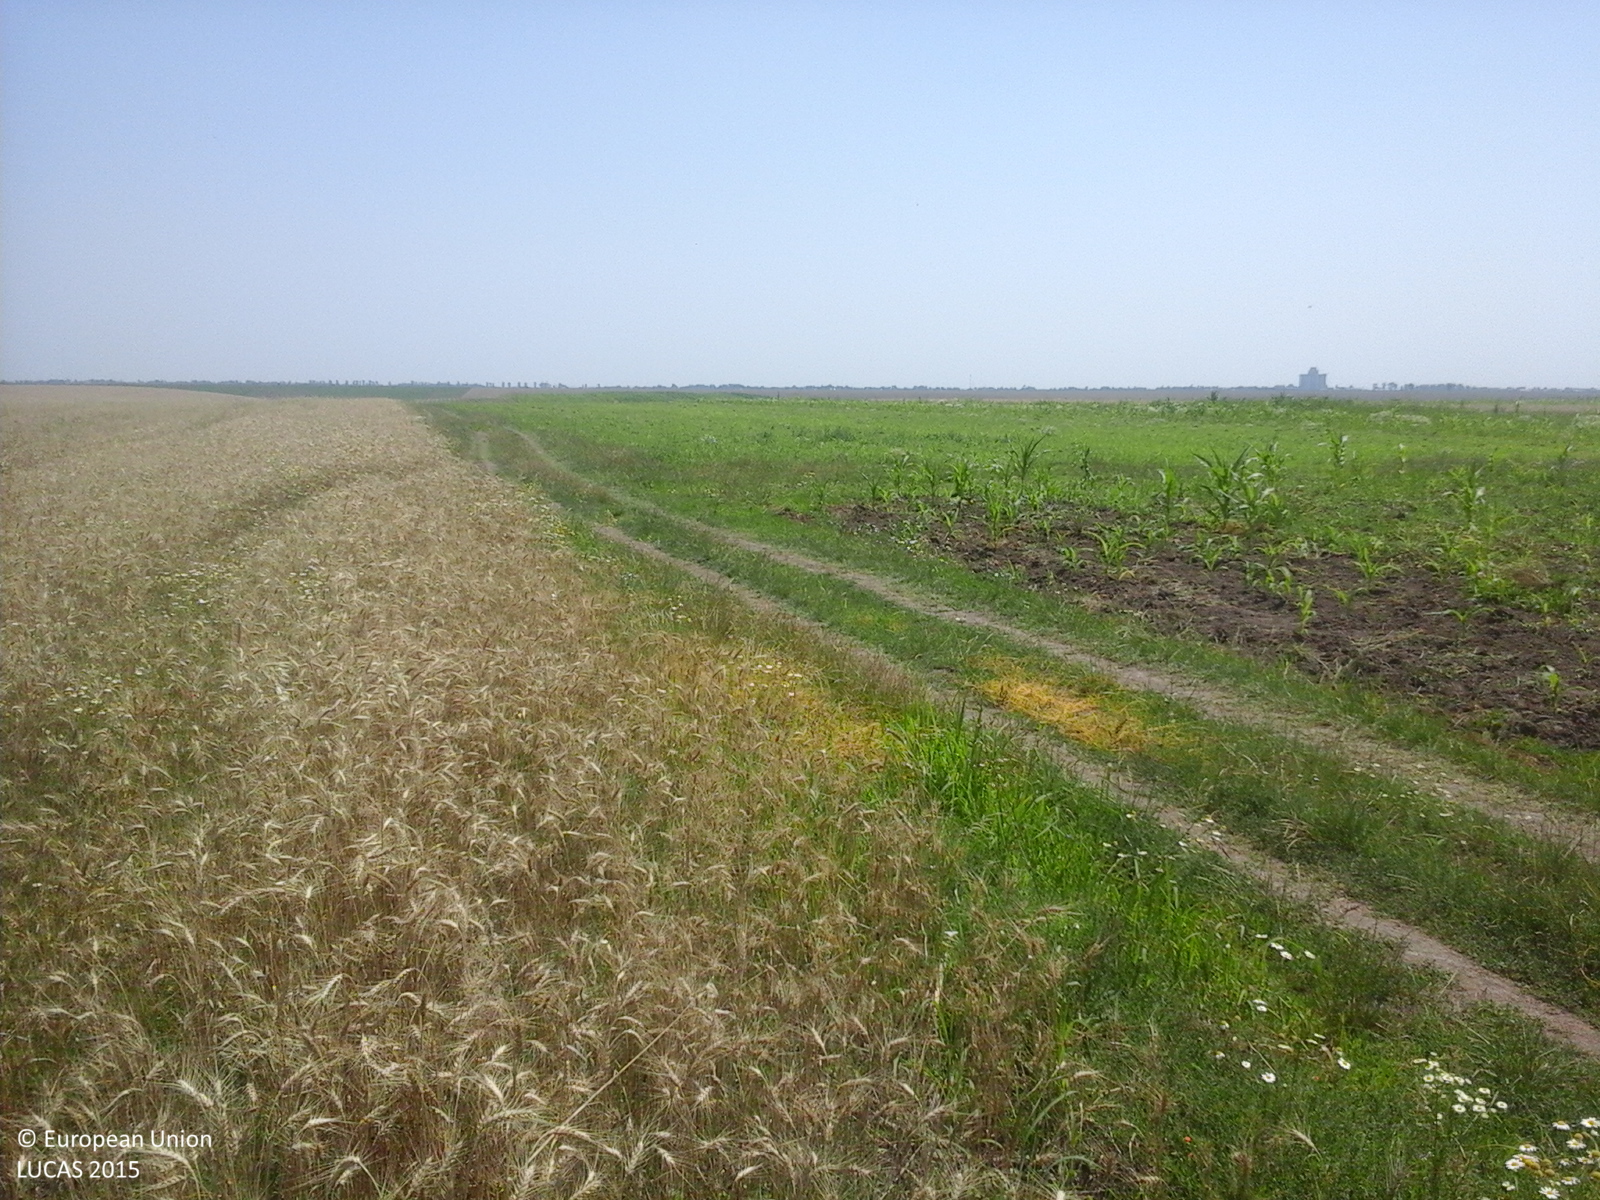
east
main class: Cropland
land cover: Mixed cereals for fodder
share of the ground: > 75 %
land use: Agriculture (excluding fallow land and kitchen gardens)
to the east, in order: Mixed cereals for fodder
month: July
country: RO
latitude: 44.4587
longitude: 24.8963
